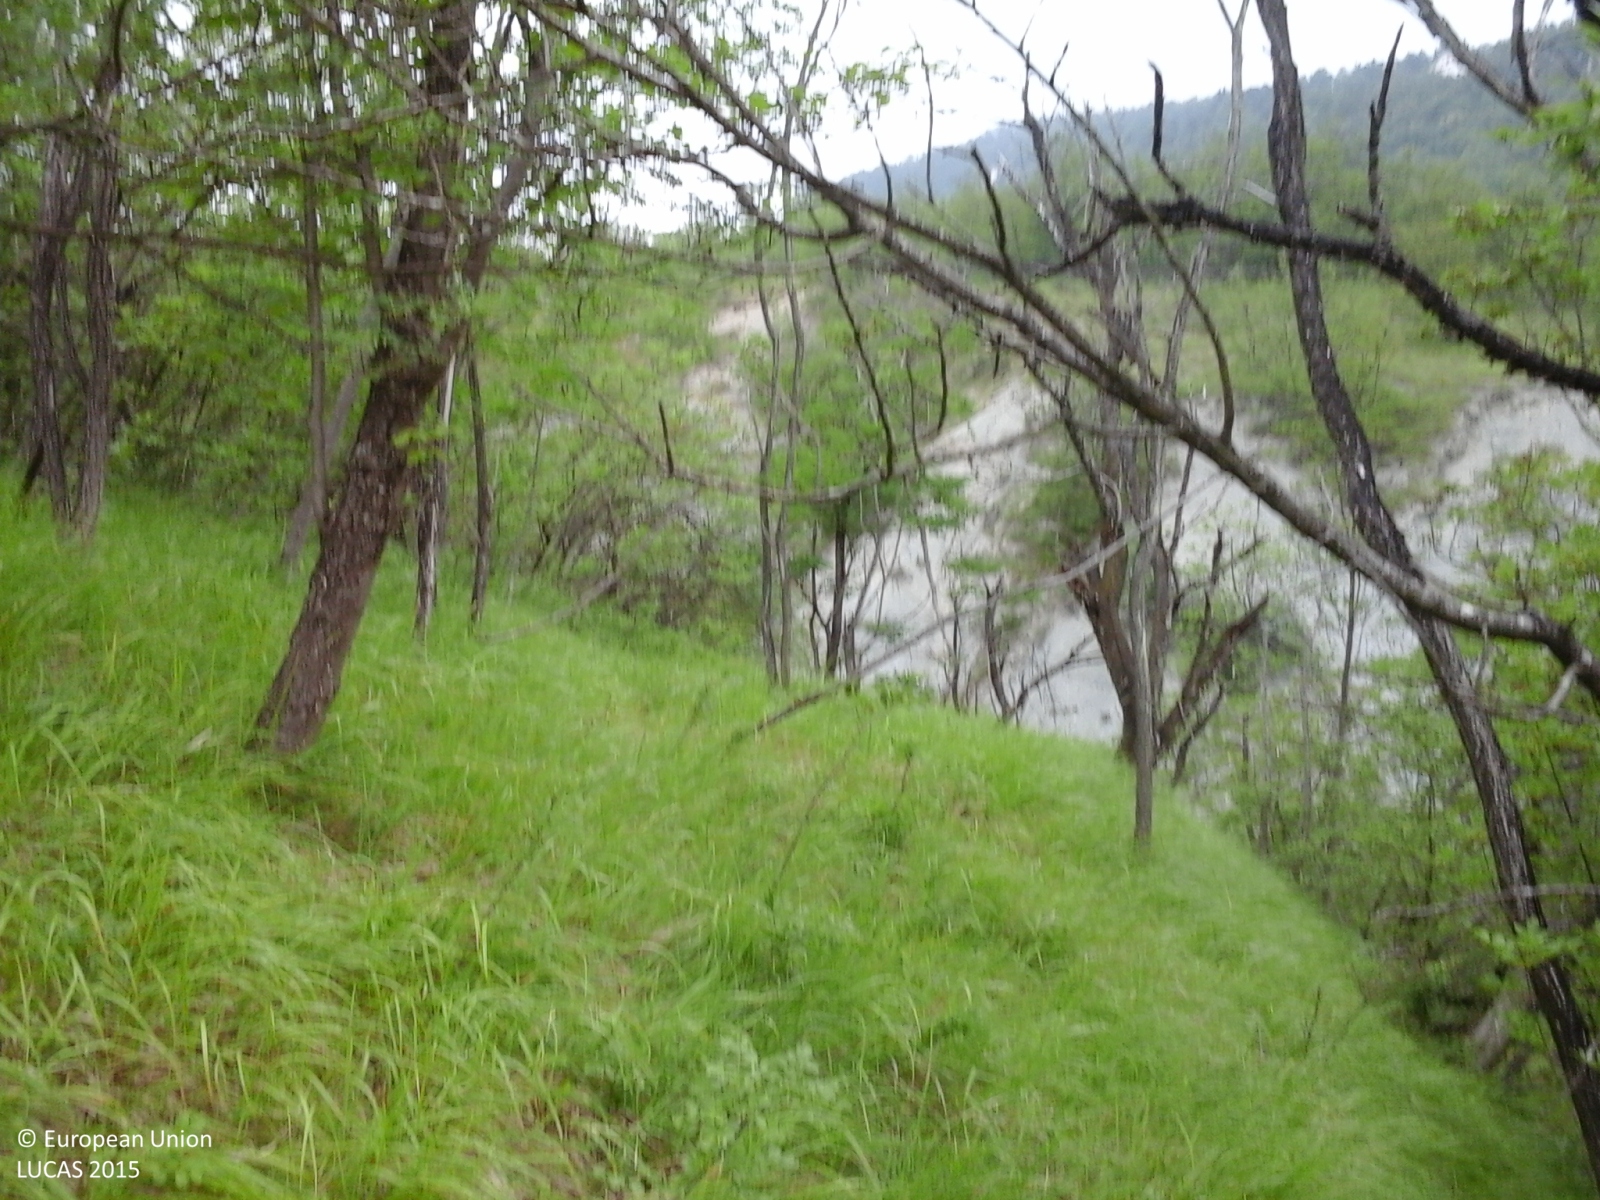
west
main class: Woodland
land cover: Broadleaved woodland
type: thermophilous deciduous forest
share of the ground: > 75 %
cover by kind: broadleaved forest trees 65 %, herbaceous plants 25 %, shrubs 10 %
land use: Forestry
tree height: < 5 m
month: June
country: IT
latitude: 44.6107
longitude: 8.5288
